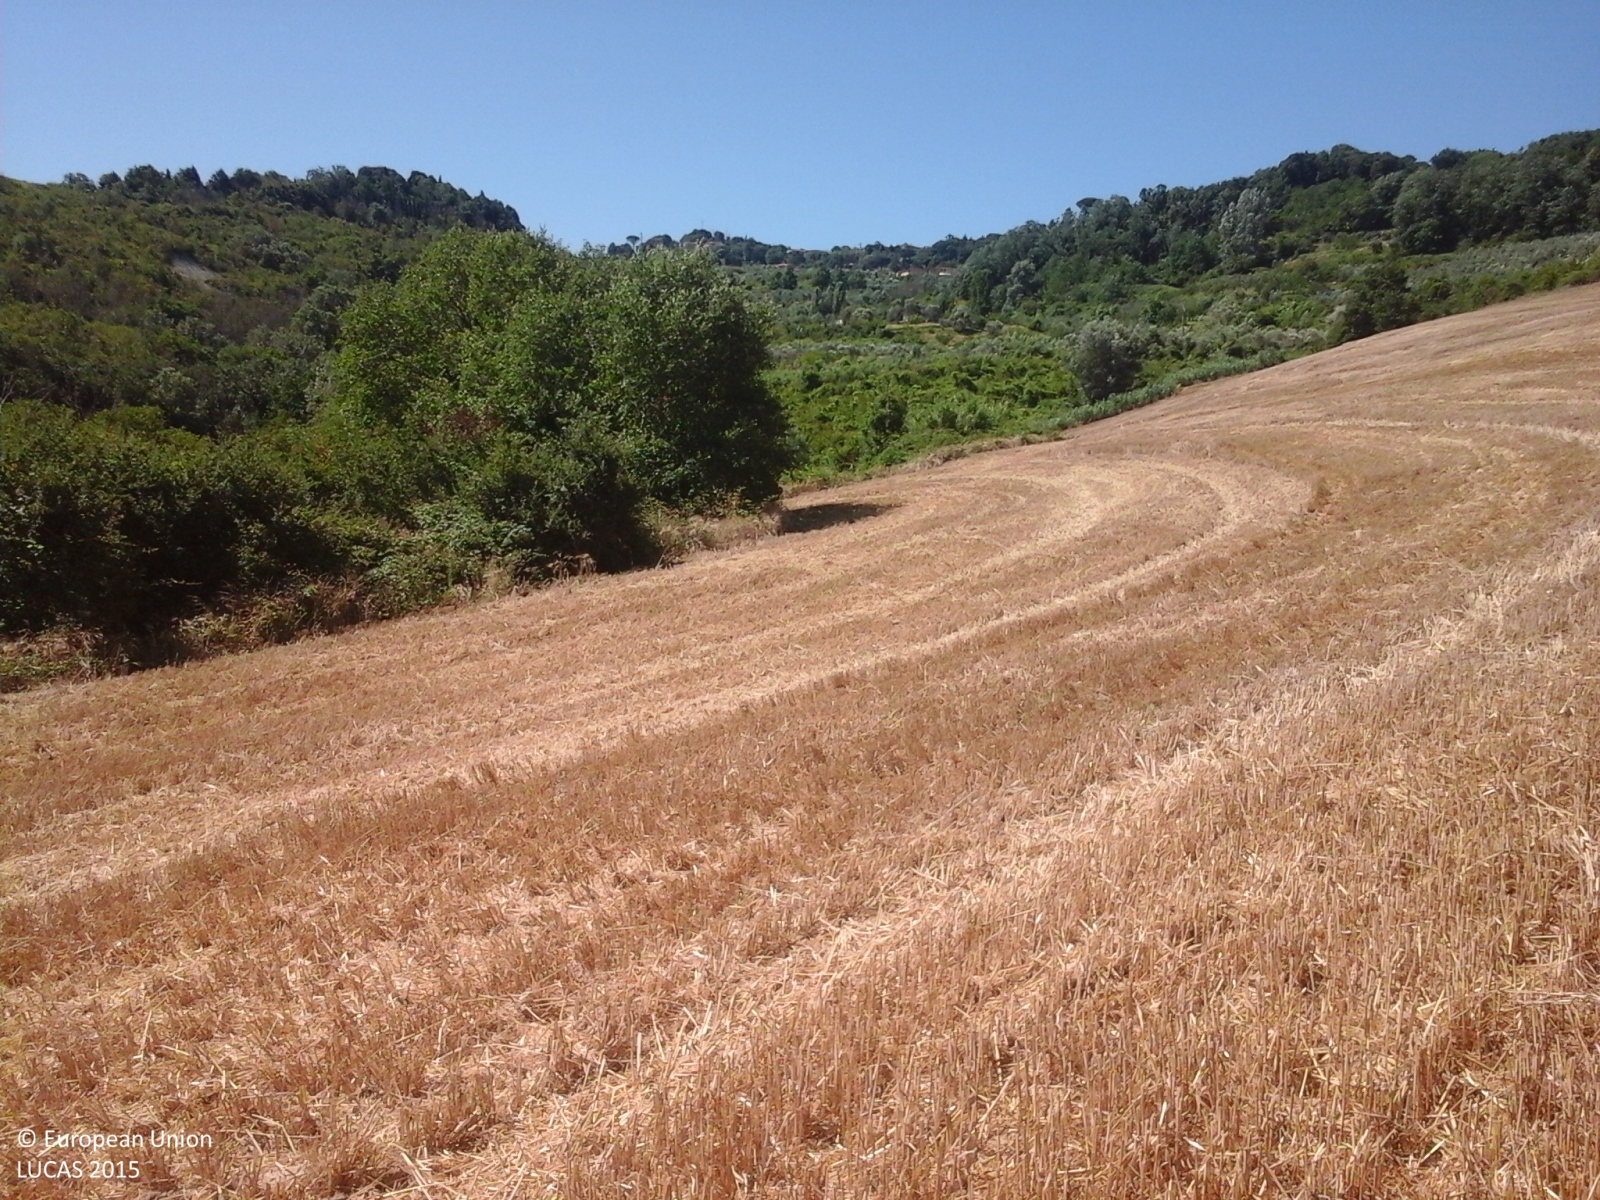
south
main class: Cropland
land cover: Durum wheat
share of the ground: > 75 %
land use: Agriculture (excluding fallow land and kitchen gardens)
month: June
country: IT
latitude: 43.5369
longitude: 10.6047
